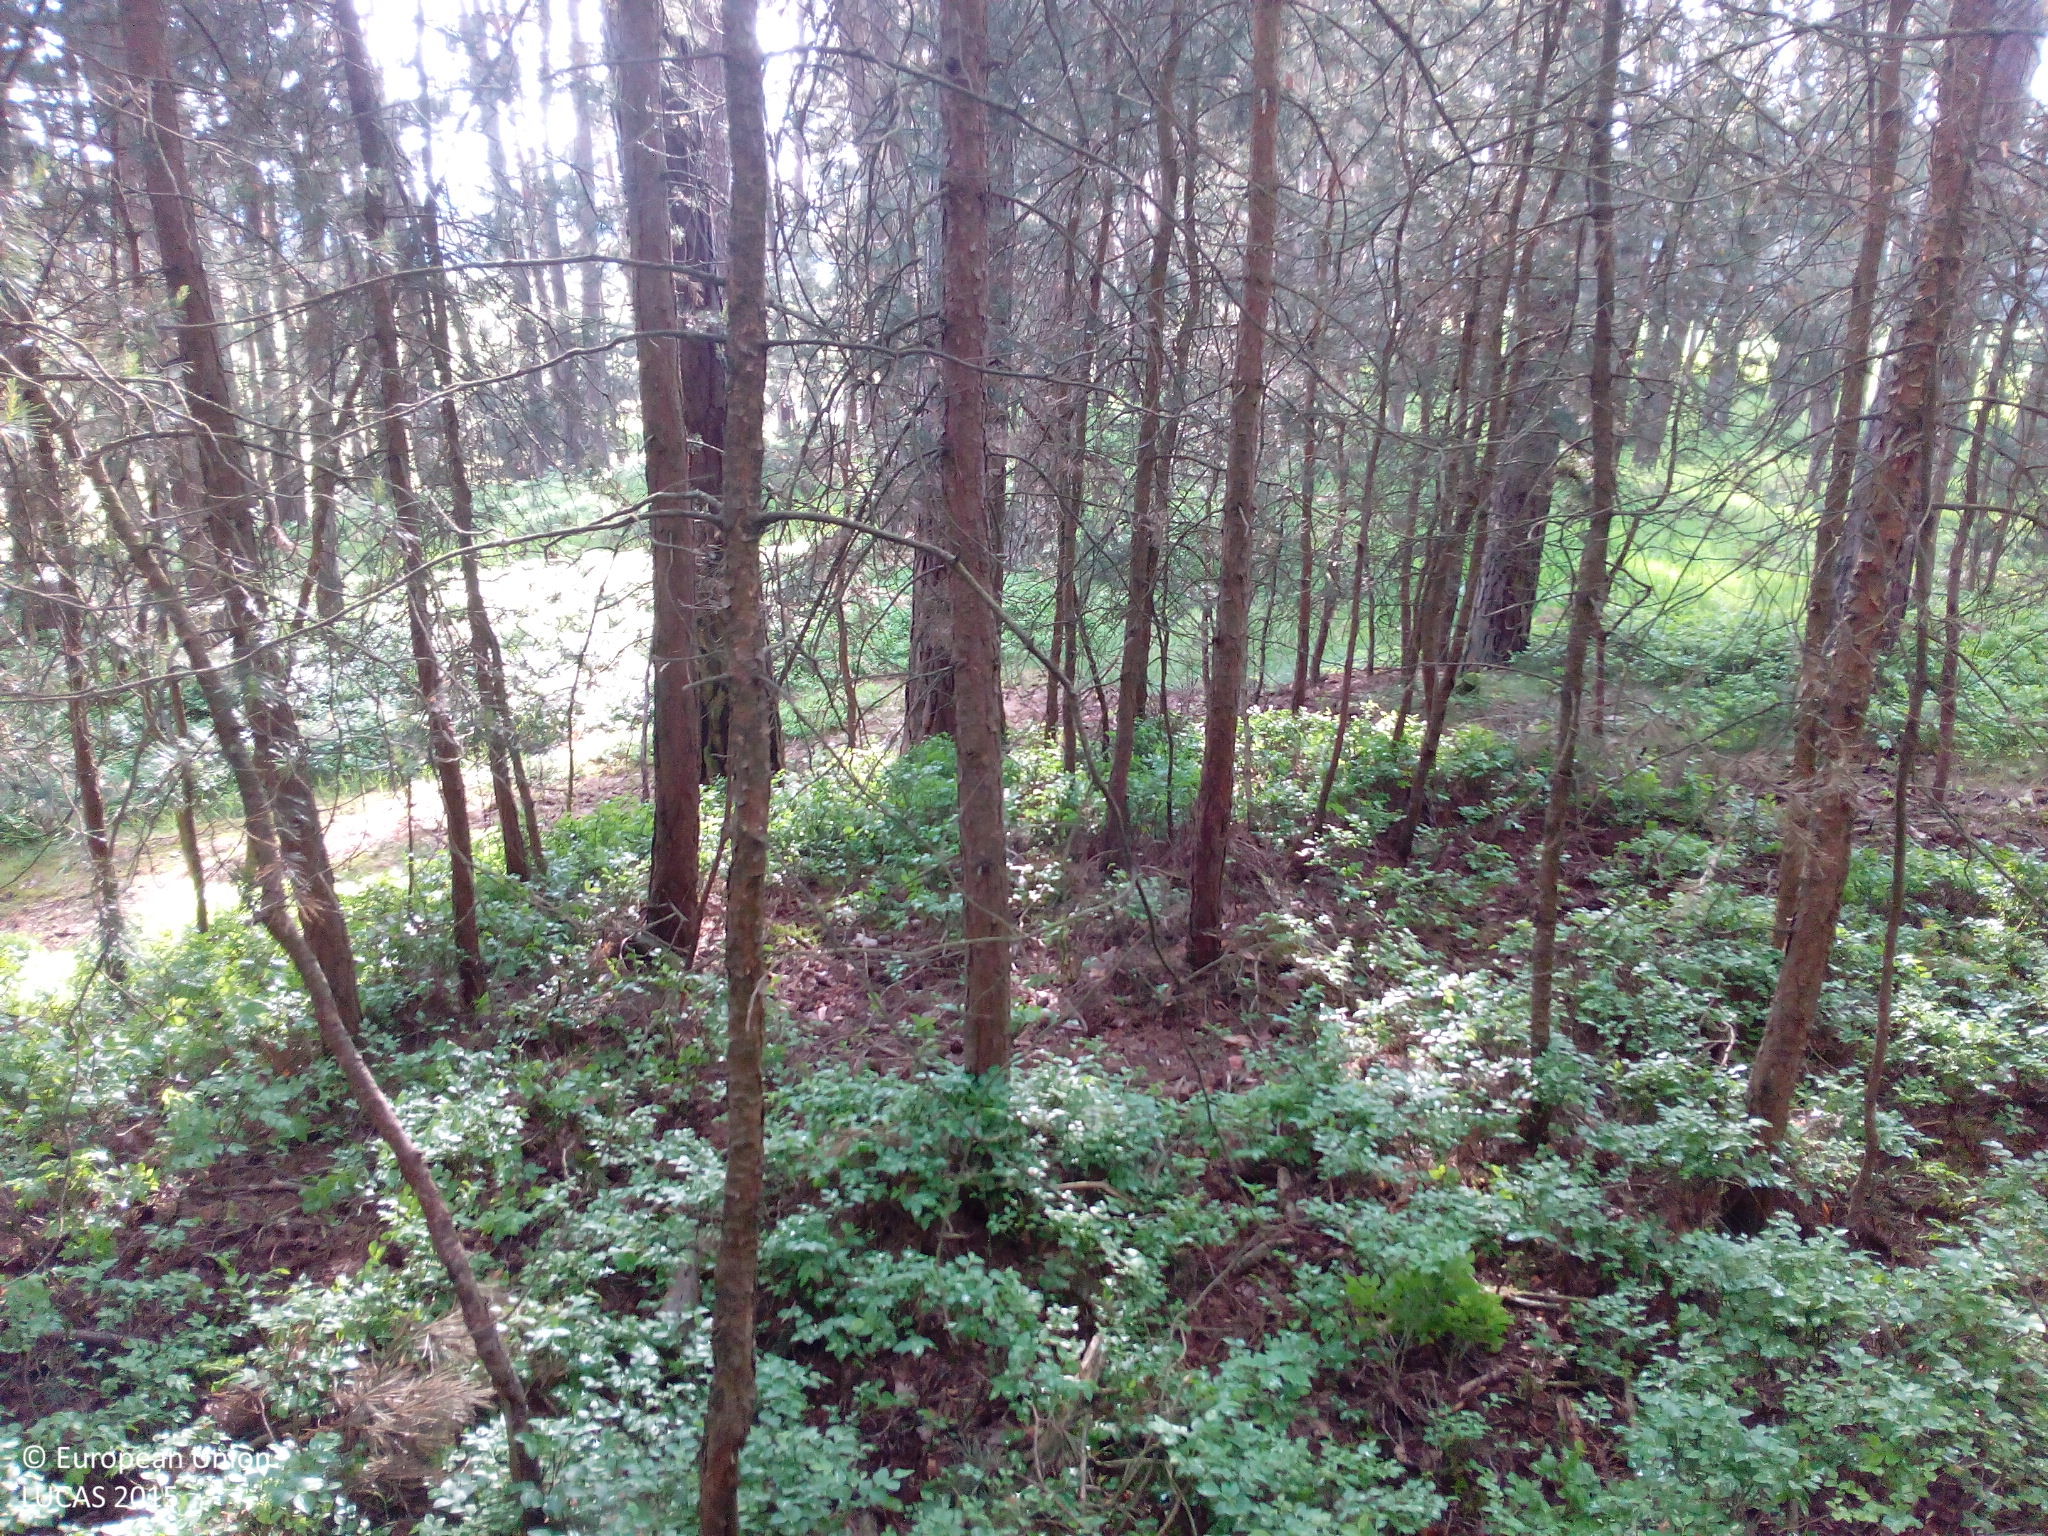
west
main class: Woodland
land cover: Pine dominated coniferous woodland
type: hemiboreal forest and nemoral coniferous forest and mixed broadleaved-coniferous forest
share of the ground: > 75 %
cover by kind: coniferous forest trees 95 %, herbaceous plants 5 %
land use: Forestry
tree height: > 5 m
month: May
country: DE
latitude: 49.1218
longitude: 10.5342
